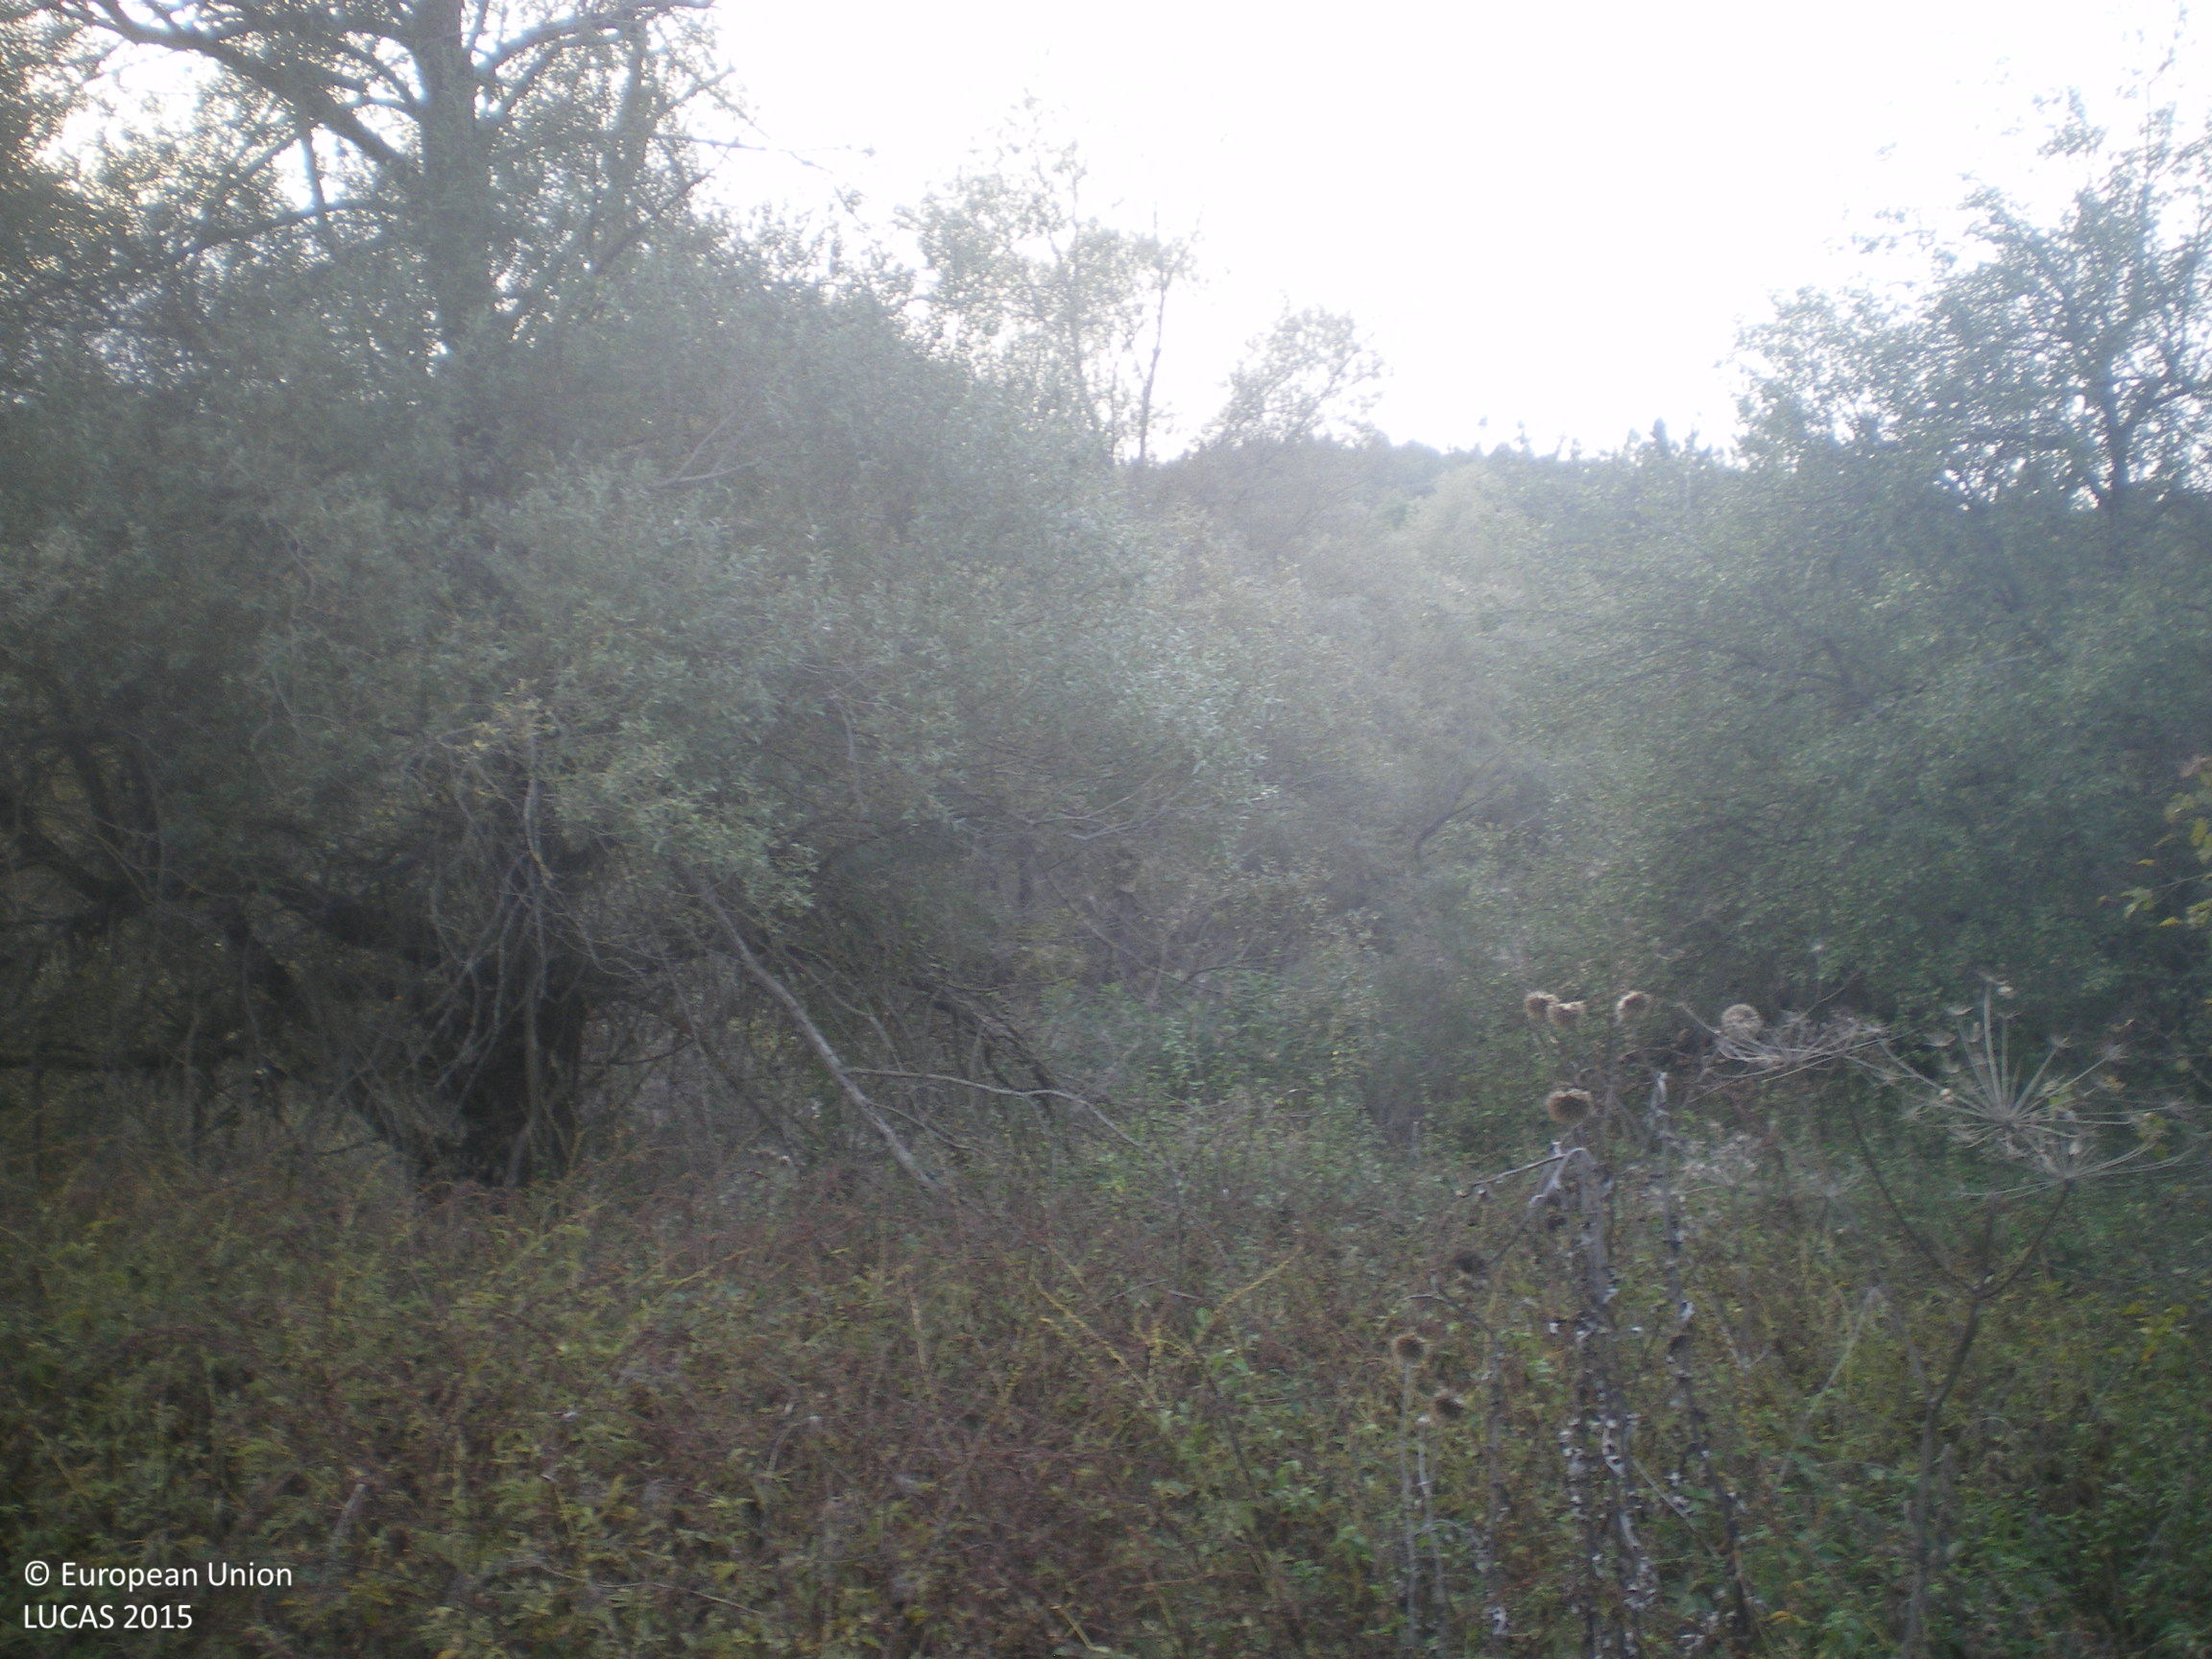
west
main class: Grassland
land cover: Grassland with sparse tree/shrub cover
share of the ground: > 75 %
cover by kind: herbaceous plants 90 %, broadleaved forest trees 5 %, shrubs 5 %
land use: Agriculture (excluding fallow land and kitchen gardens)
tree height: > 5 m
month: October
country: BG
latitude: 42.0901
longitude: 26.2205
